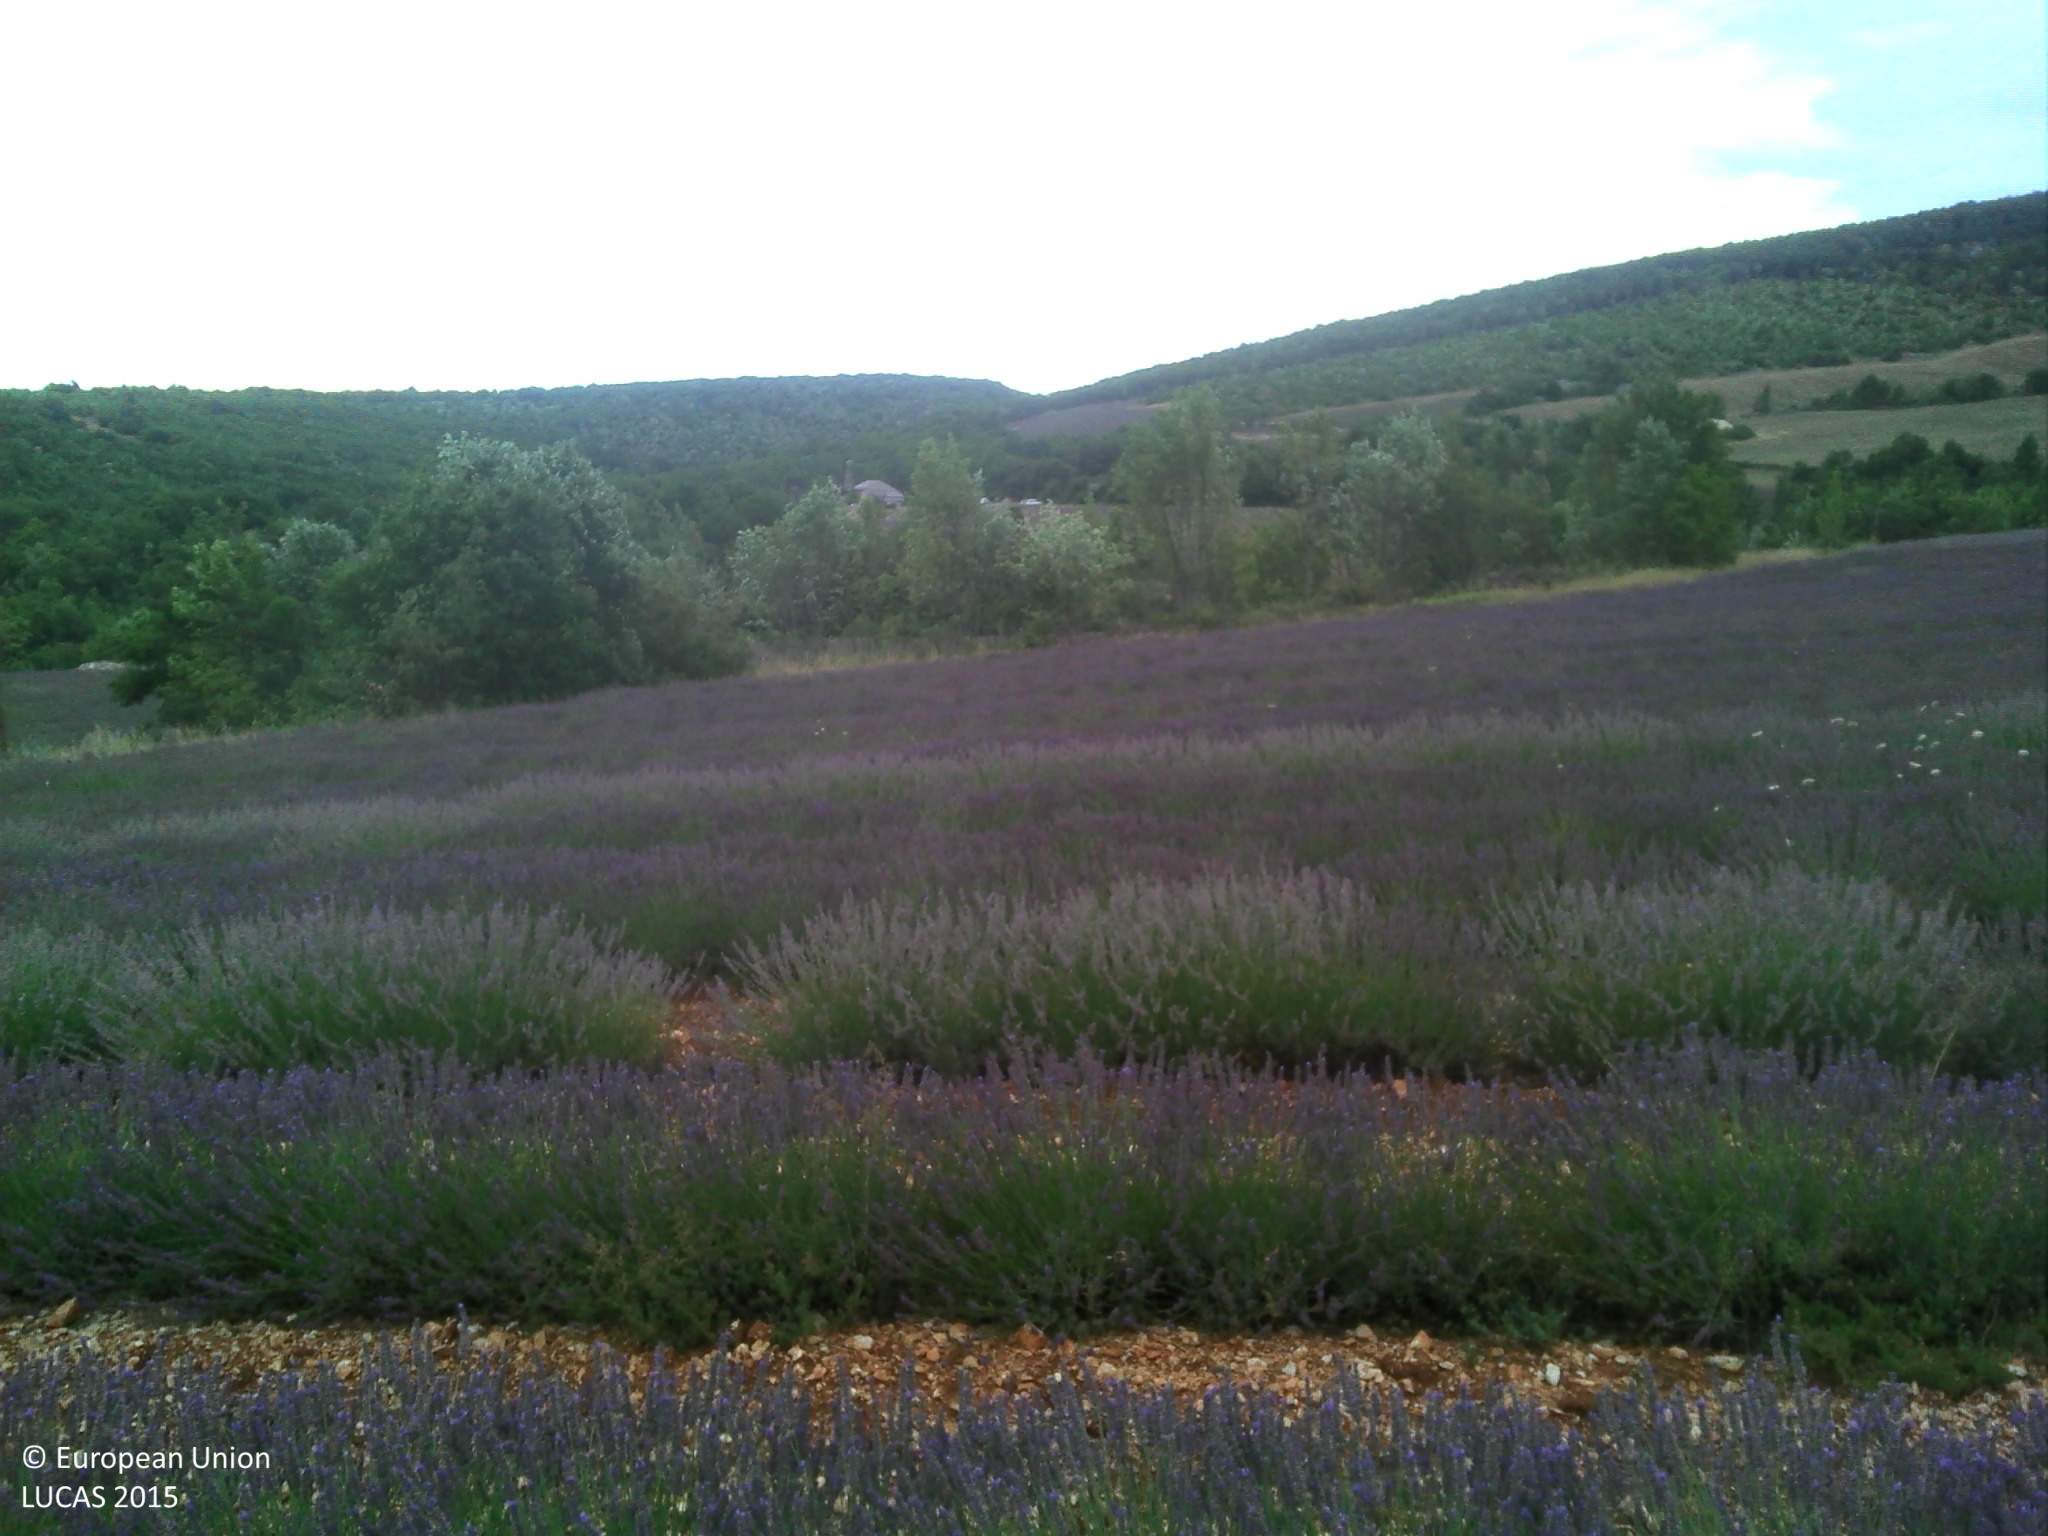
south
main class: Cropland
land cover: Permanent industrial crops
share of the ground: 50 - 75 %
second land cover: Other bare soil
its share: > 75 %
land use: Agriculture (excluding fallow land and kitchen gardens)
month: July
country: FR
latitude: 43.9834
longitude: 5.5325
